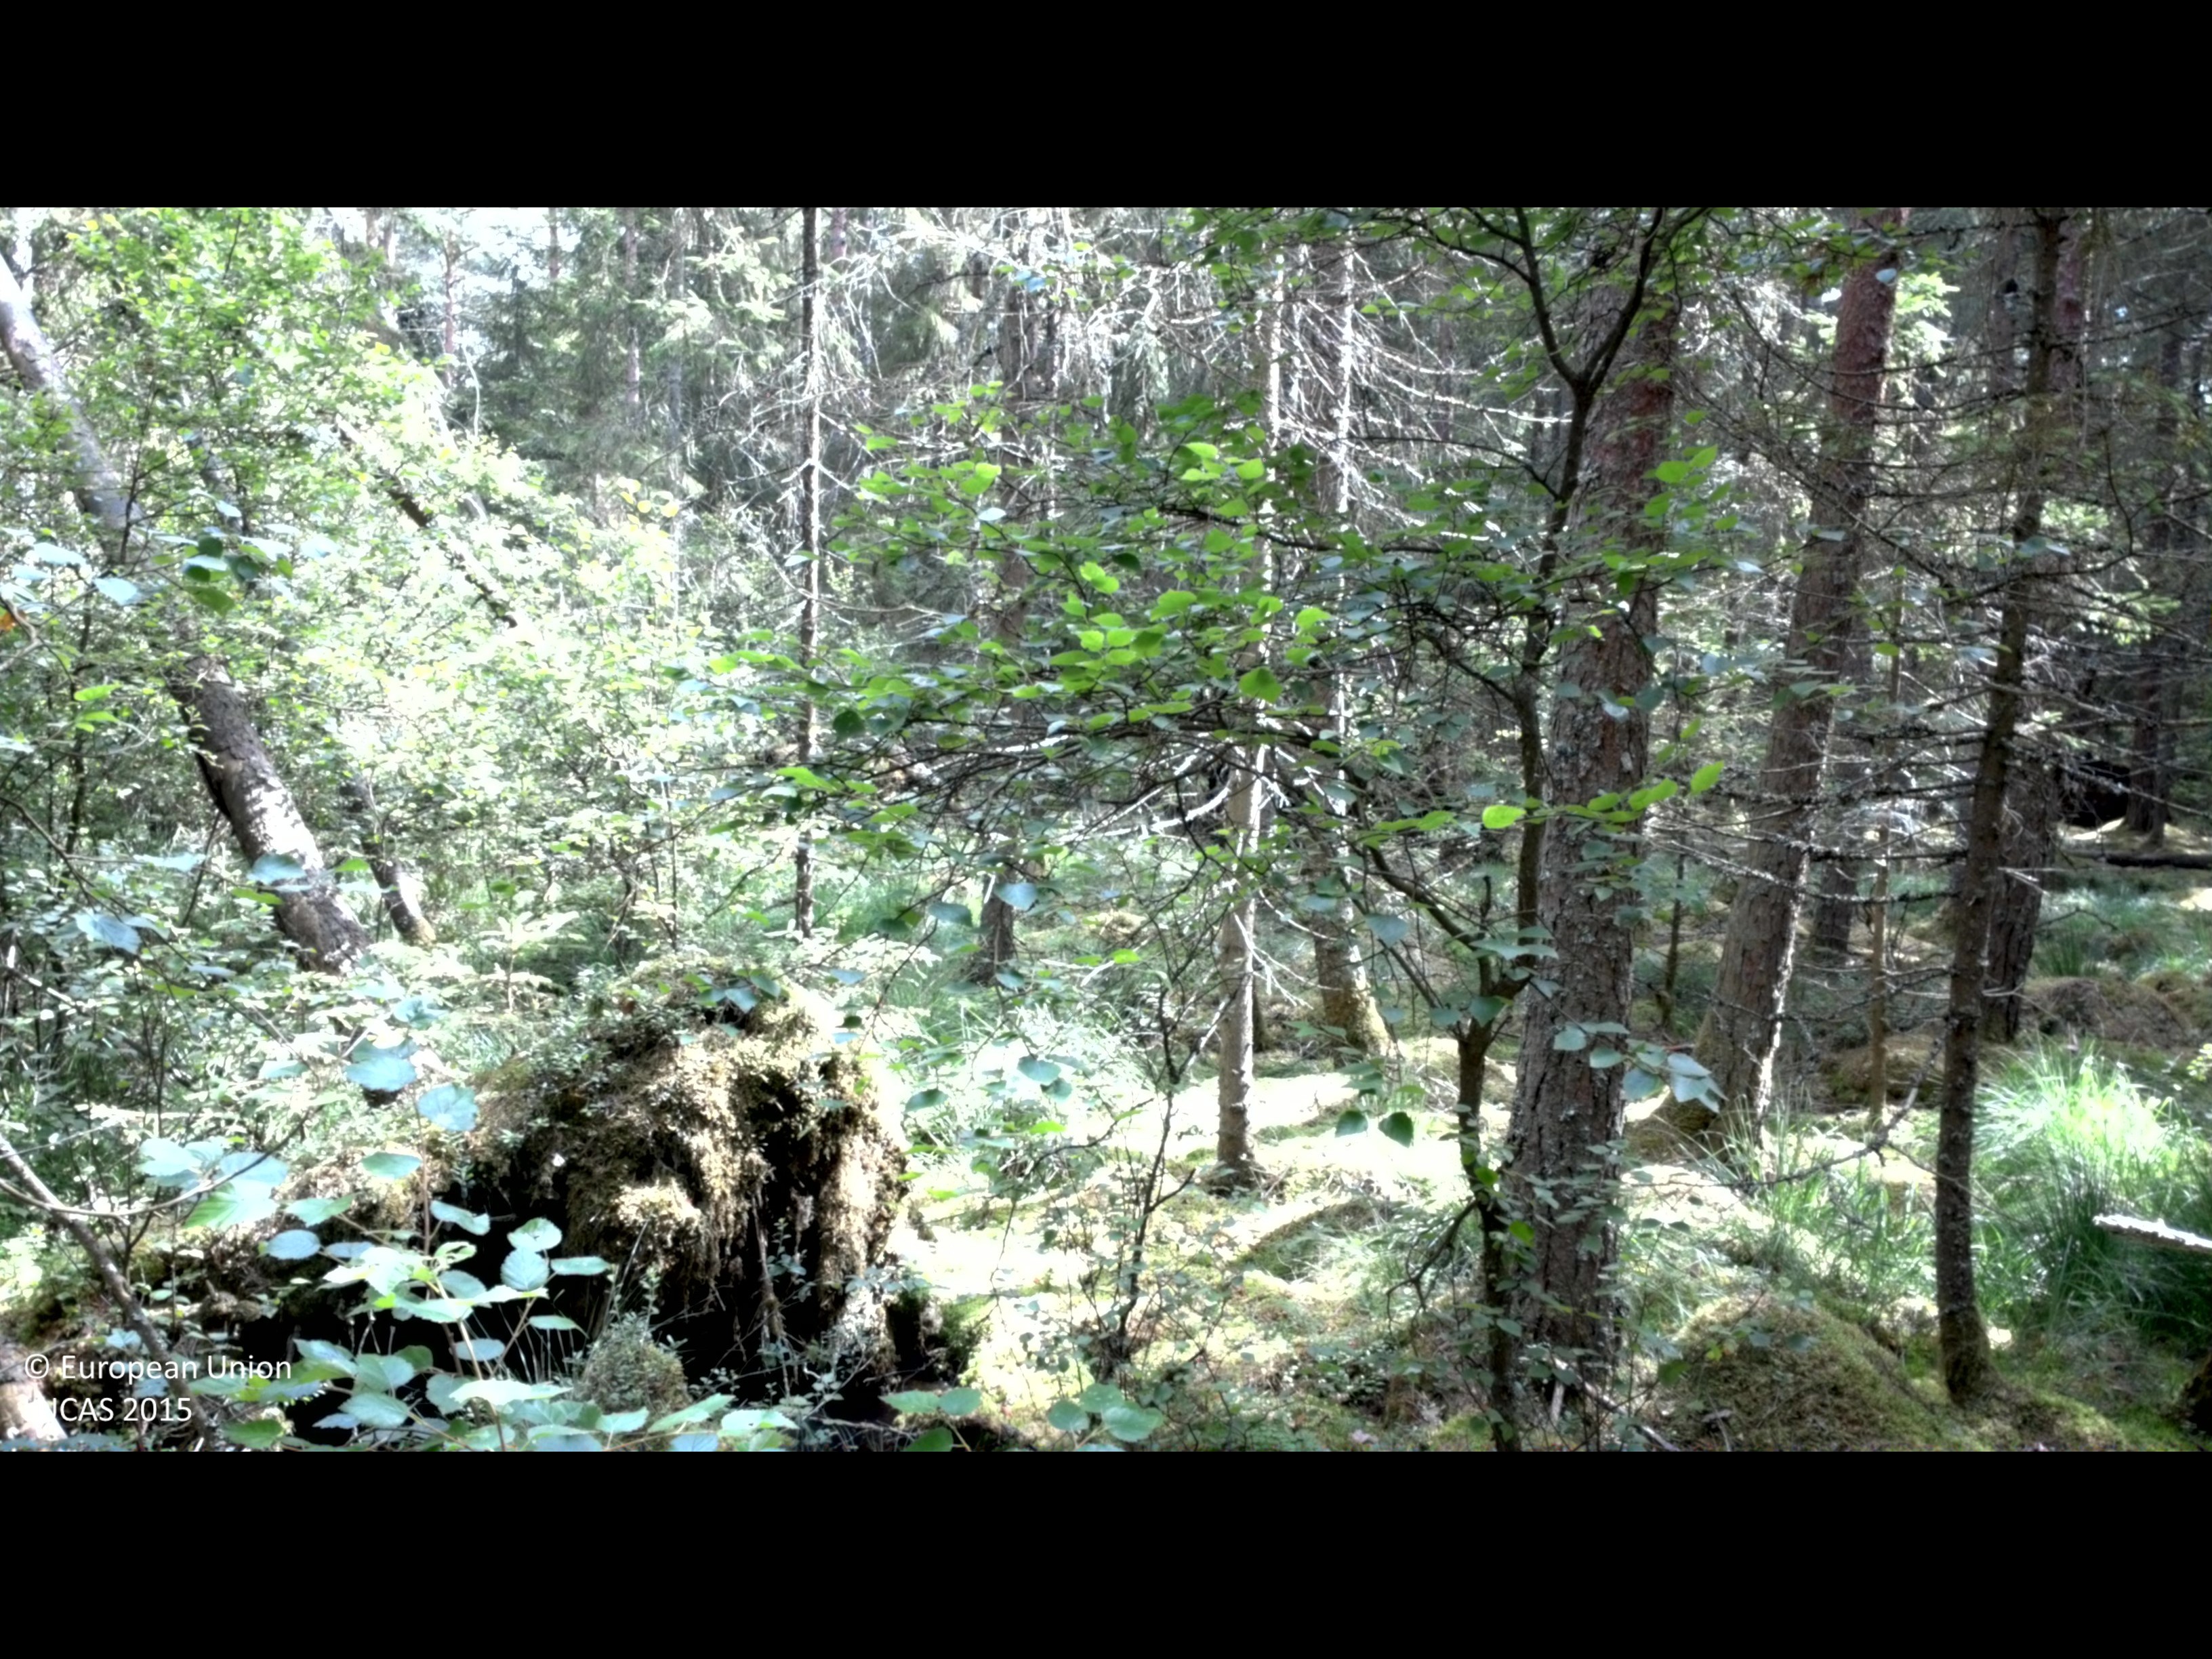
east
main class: Woodland
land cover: Spruce dominated coniferous woodland
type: boreal forest
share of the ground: > 75 %
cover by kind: coniferous forest trees 80 %, herbaceous plants 10 %, broadleaved forest trees 5 %, shrubs 5 %
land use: Forestry
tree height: > 5 m
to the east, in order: Spruce dominated coniferous woodland; Pine dominated coniferous woodland; Ditches and canals; Pine dominated coniferous woodland
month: August
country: SE
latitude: 56.7443
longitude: 13.7737
